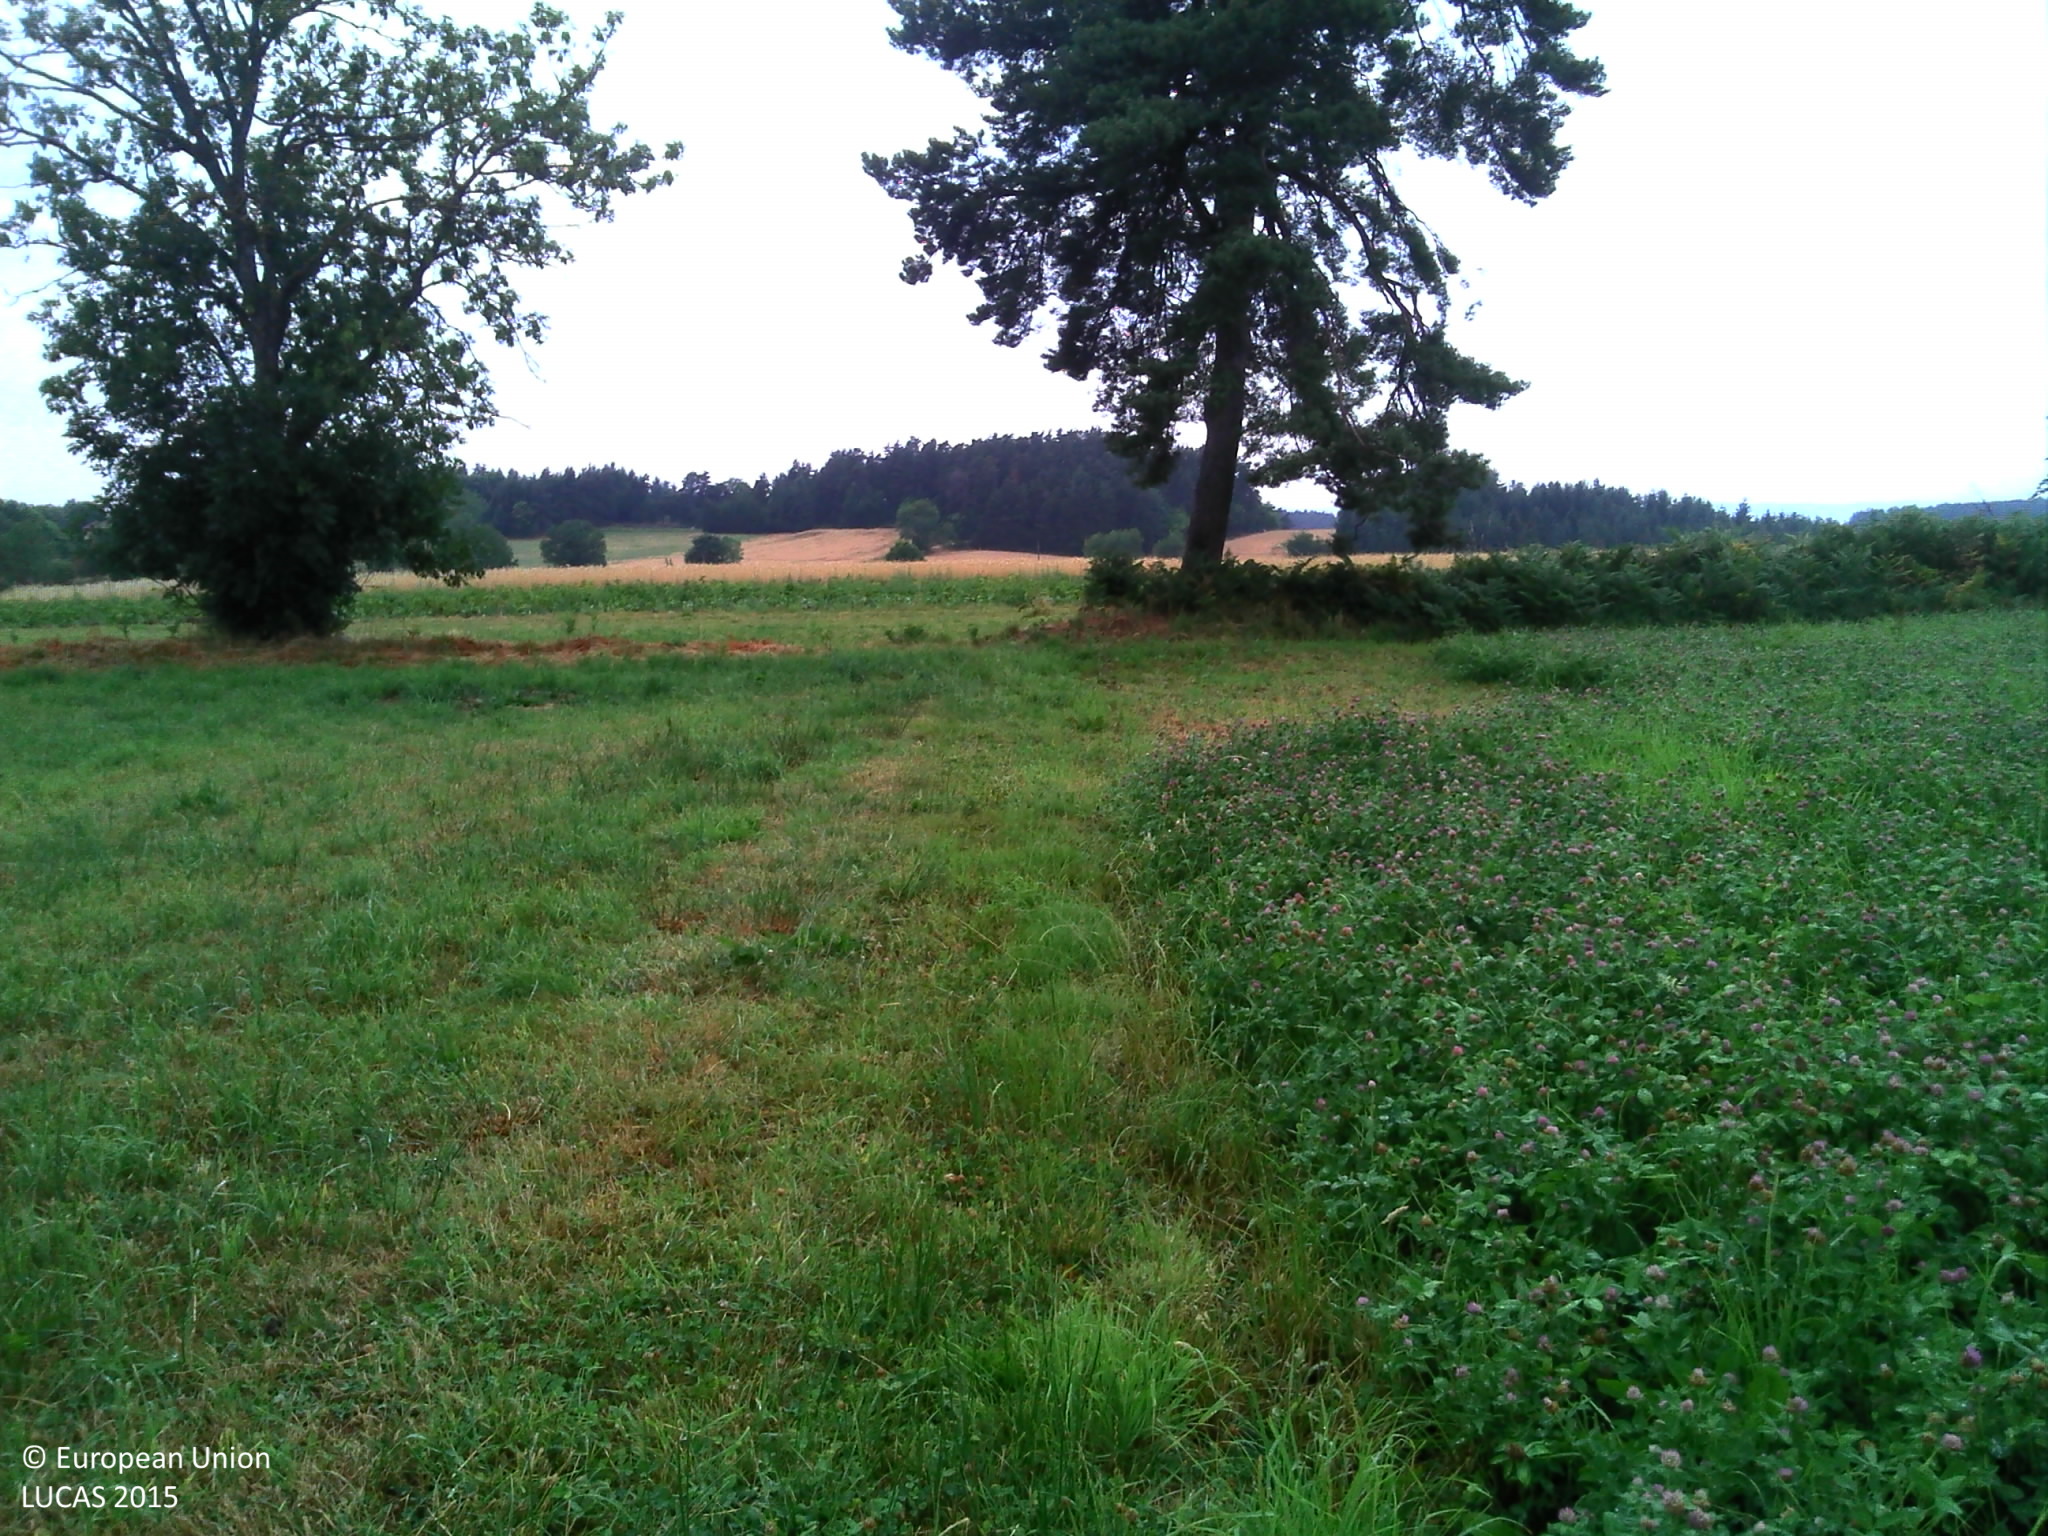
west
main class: Cropland
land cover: Clovers
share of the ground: > 75 %
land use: Kitchen garden
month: July
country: FR
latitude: 45.2564
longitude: 4.2316
